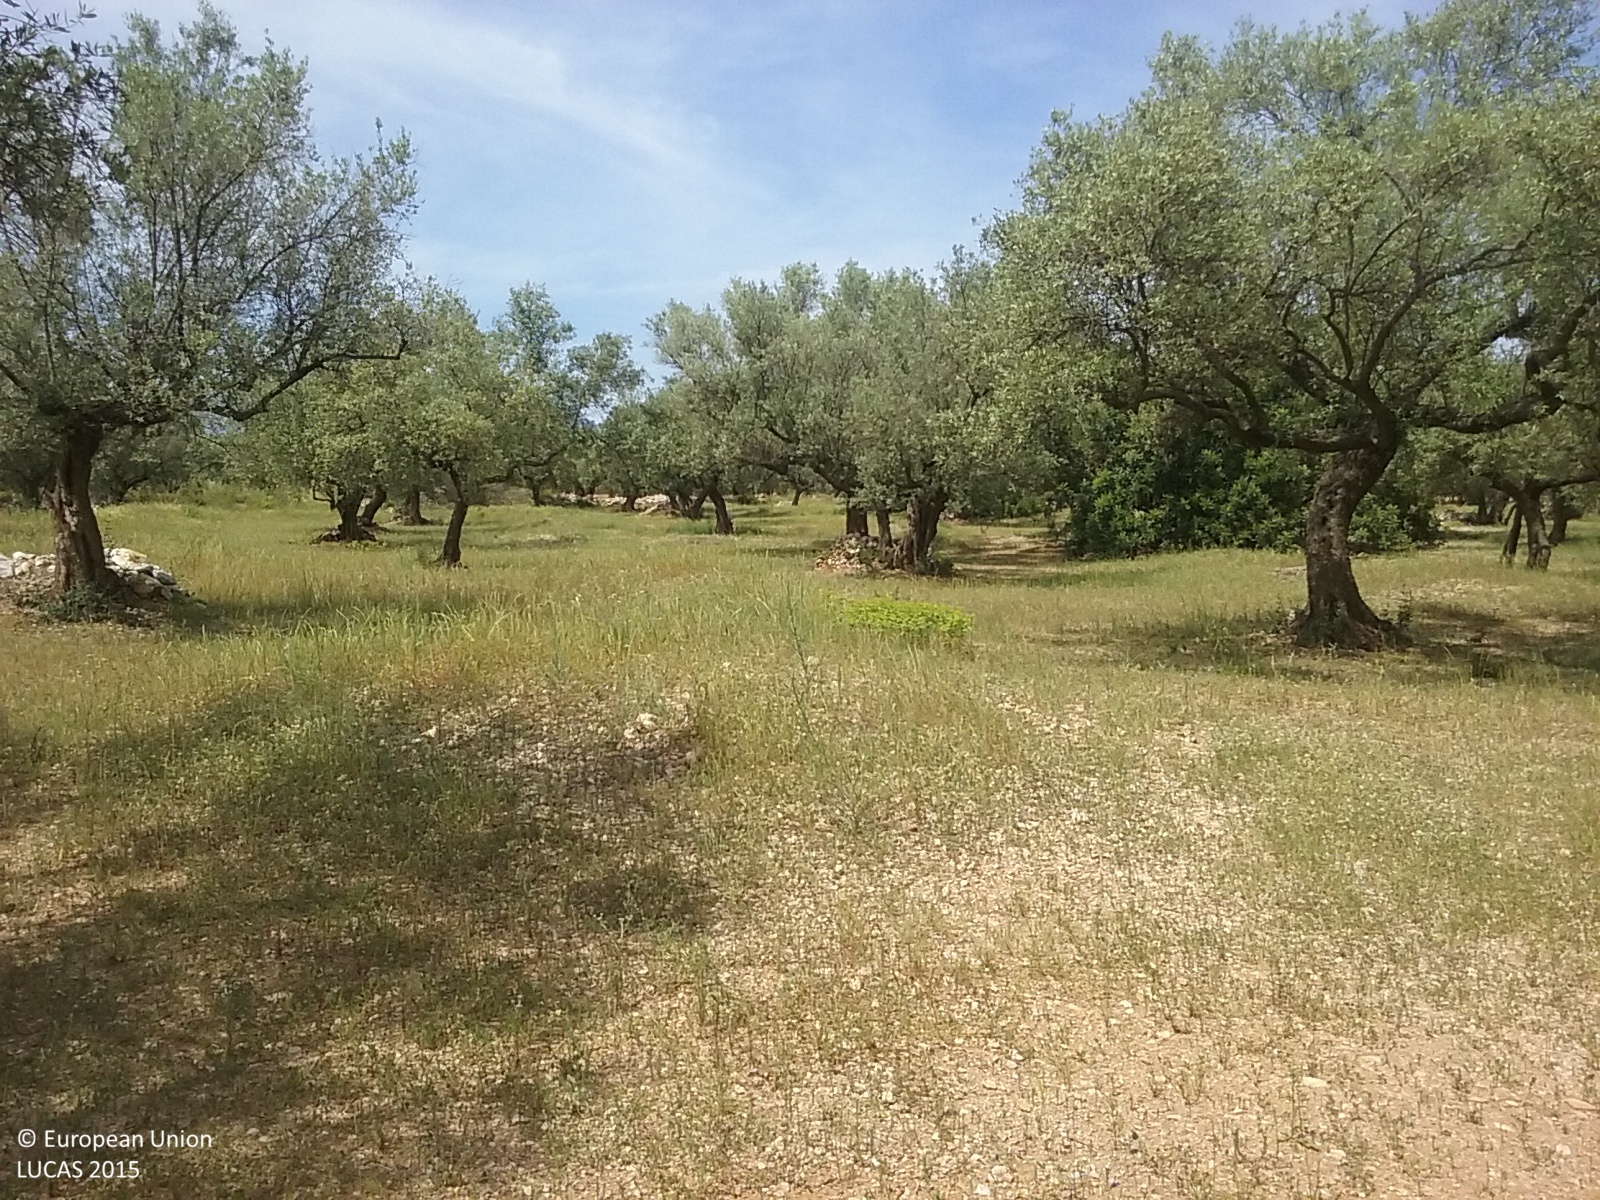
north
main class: Cropland
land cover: Olive groves
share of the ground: 25 - 50 %
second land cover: Spontaneously vegetated surfaces
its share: > 75 %
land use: Agriculture (excluding fallow land and kitchen gardens)
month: May
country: ES
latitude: 40.6874
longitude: 0.3980
